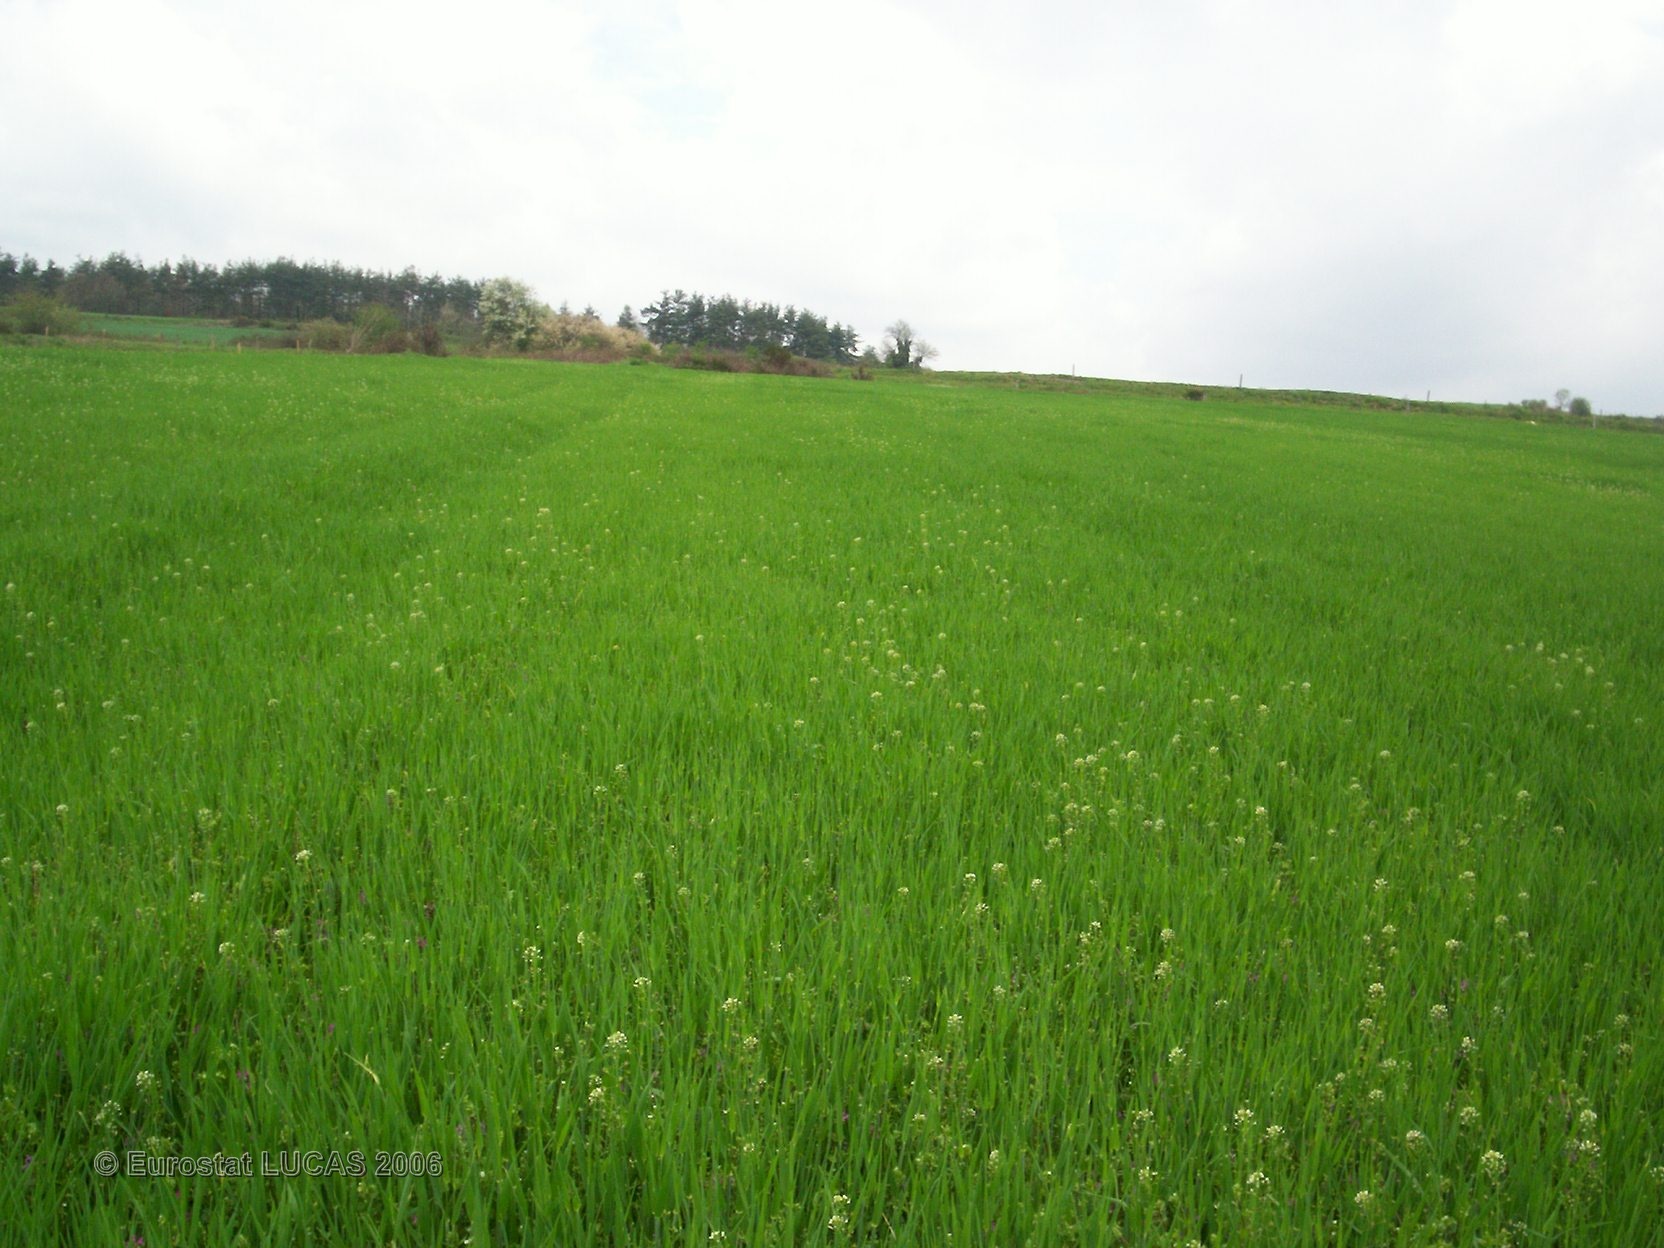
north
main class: Cropland
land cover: Barley
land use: Agriculture (excluding fallow land and kitchen gardens)
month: April
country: FR
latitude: 45.3075
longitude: 4.1752
